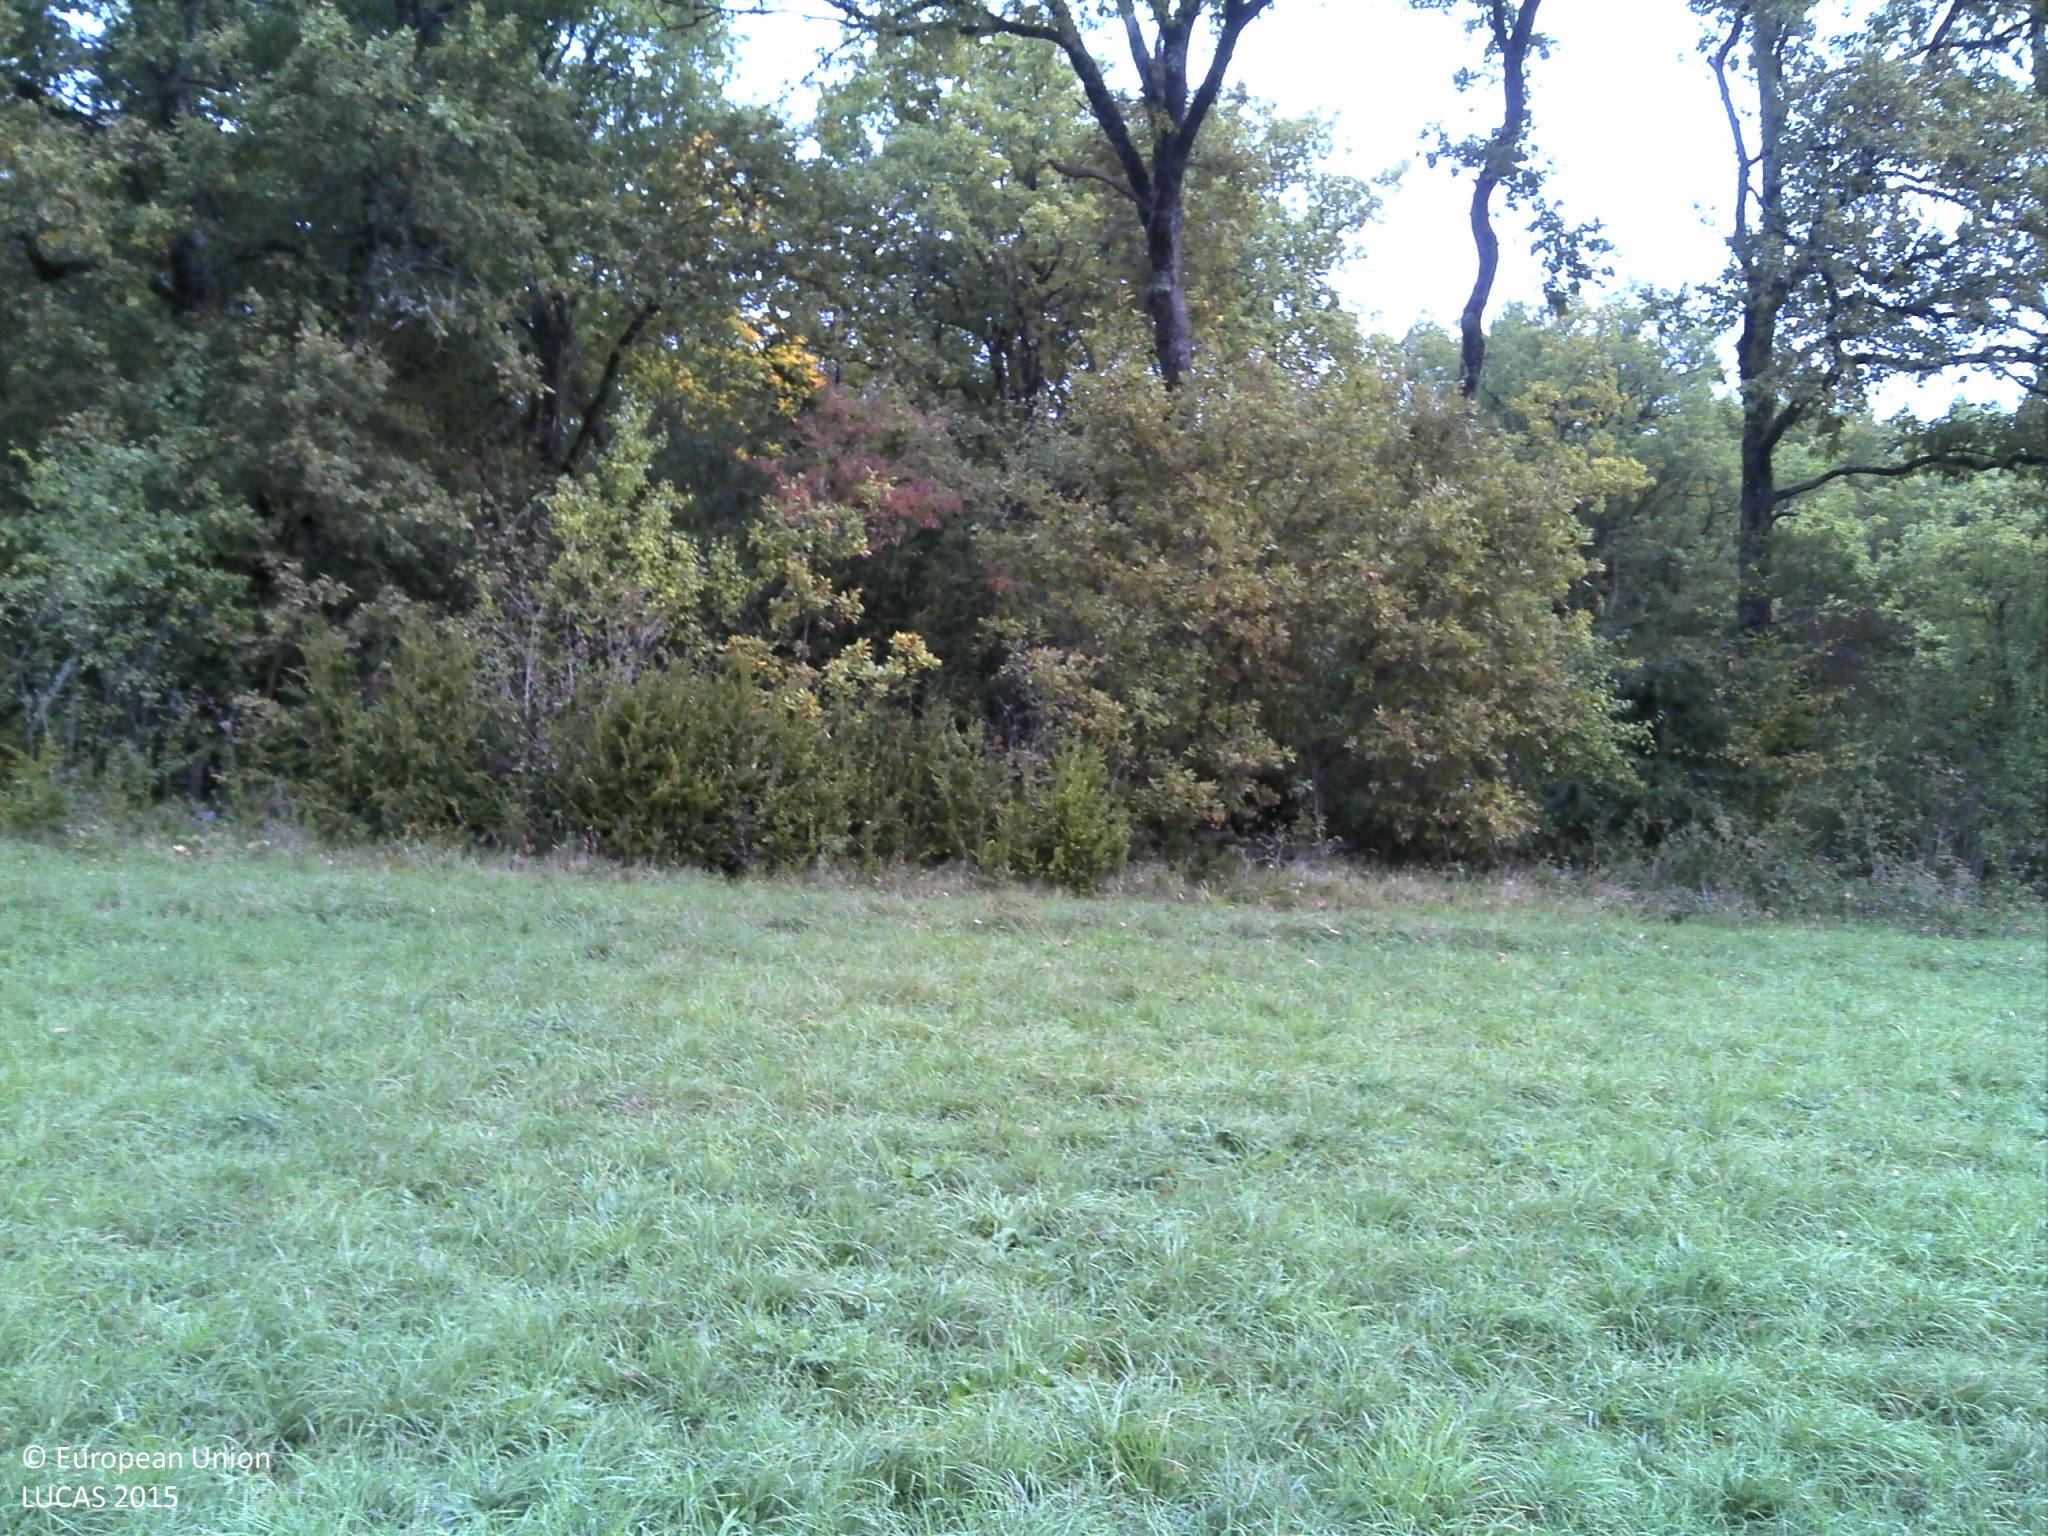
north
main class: Grassland
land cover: Grassland without tree/shrub cover
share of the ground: > 75 %
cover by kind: herbaceous plants 100 %
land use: Agriculture (excluding fallow land and kitchen gardens)
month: October
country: FR
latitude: 46.1242
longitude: 5.3573
